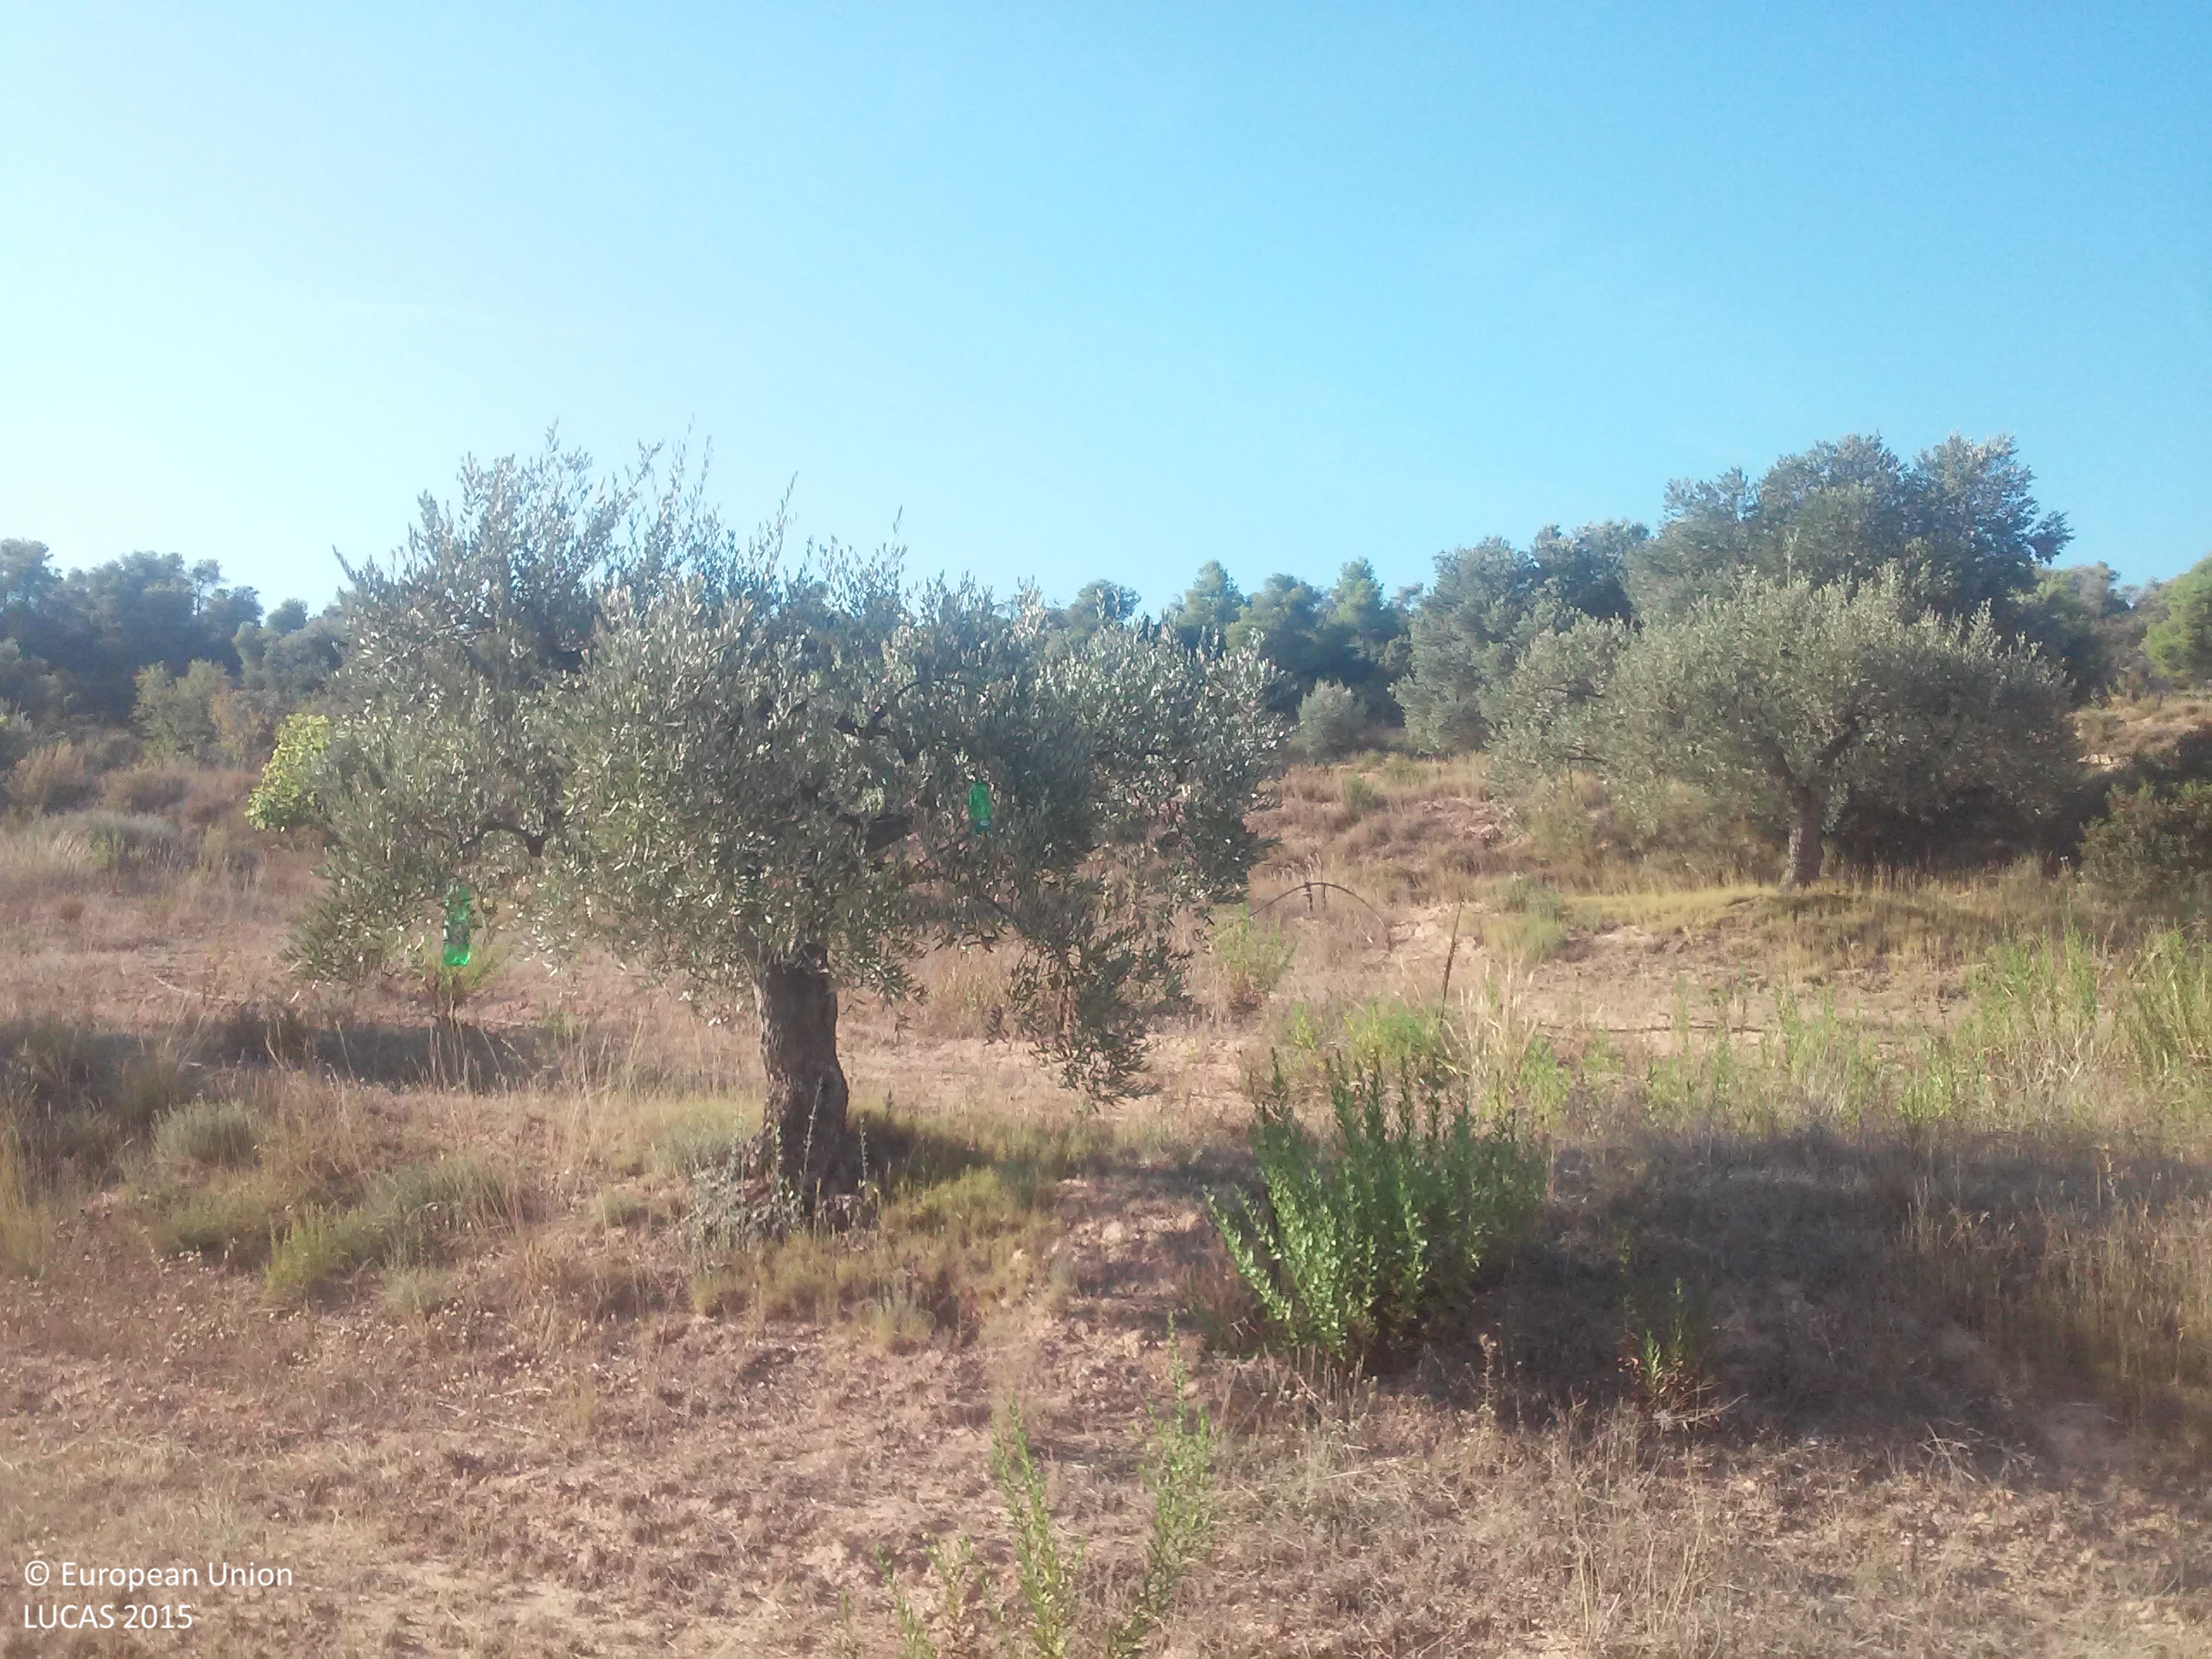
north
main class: Cropland
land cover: Olive groves
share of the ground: 10 - 25 %
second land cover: Grassland without tree/shrub cover
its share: > 75 %
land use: Agriculture (excluding fallow land and kitchen gardens)
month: August
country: ES
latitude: 41.2524
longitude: 0.5983
